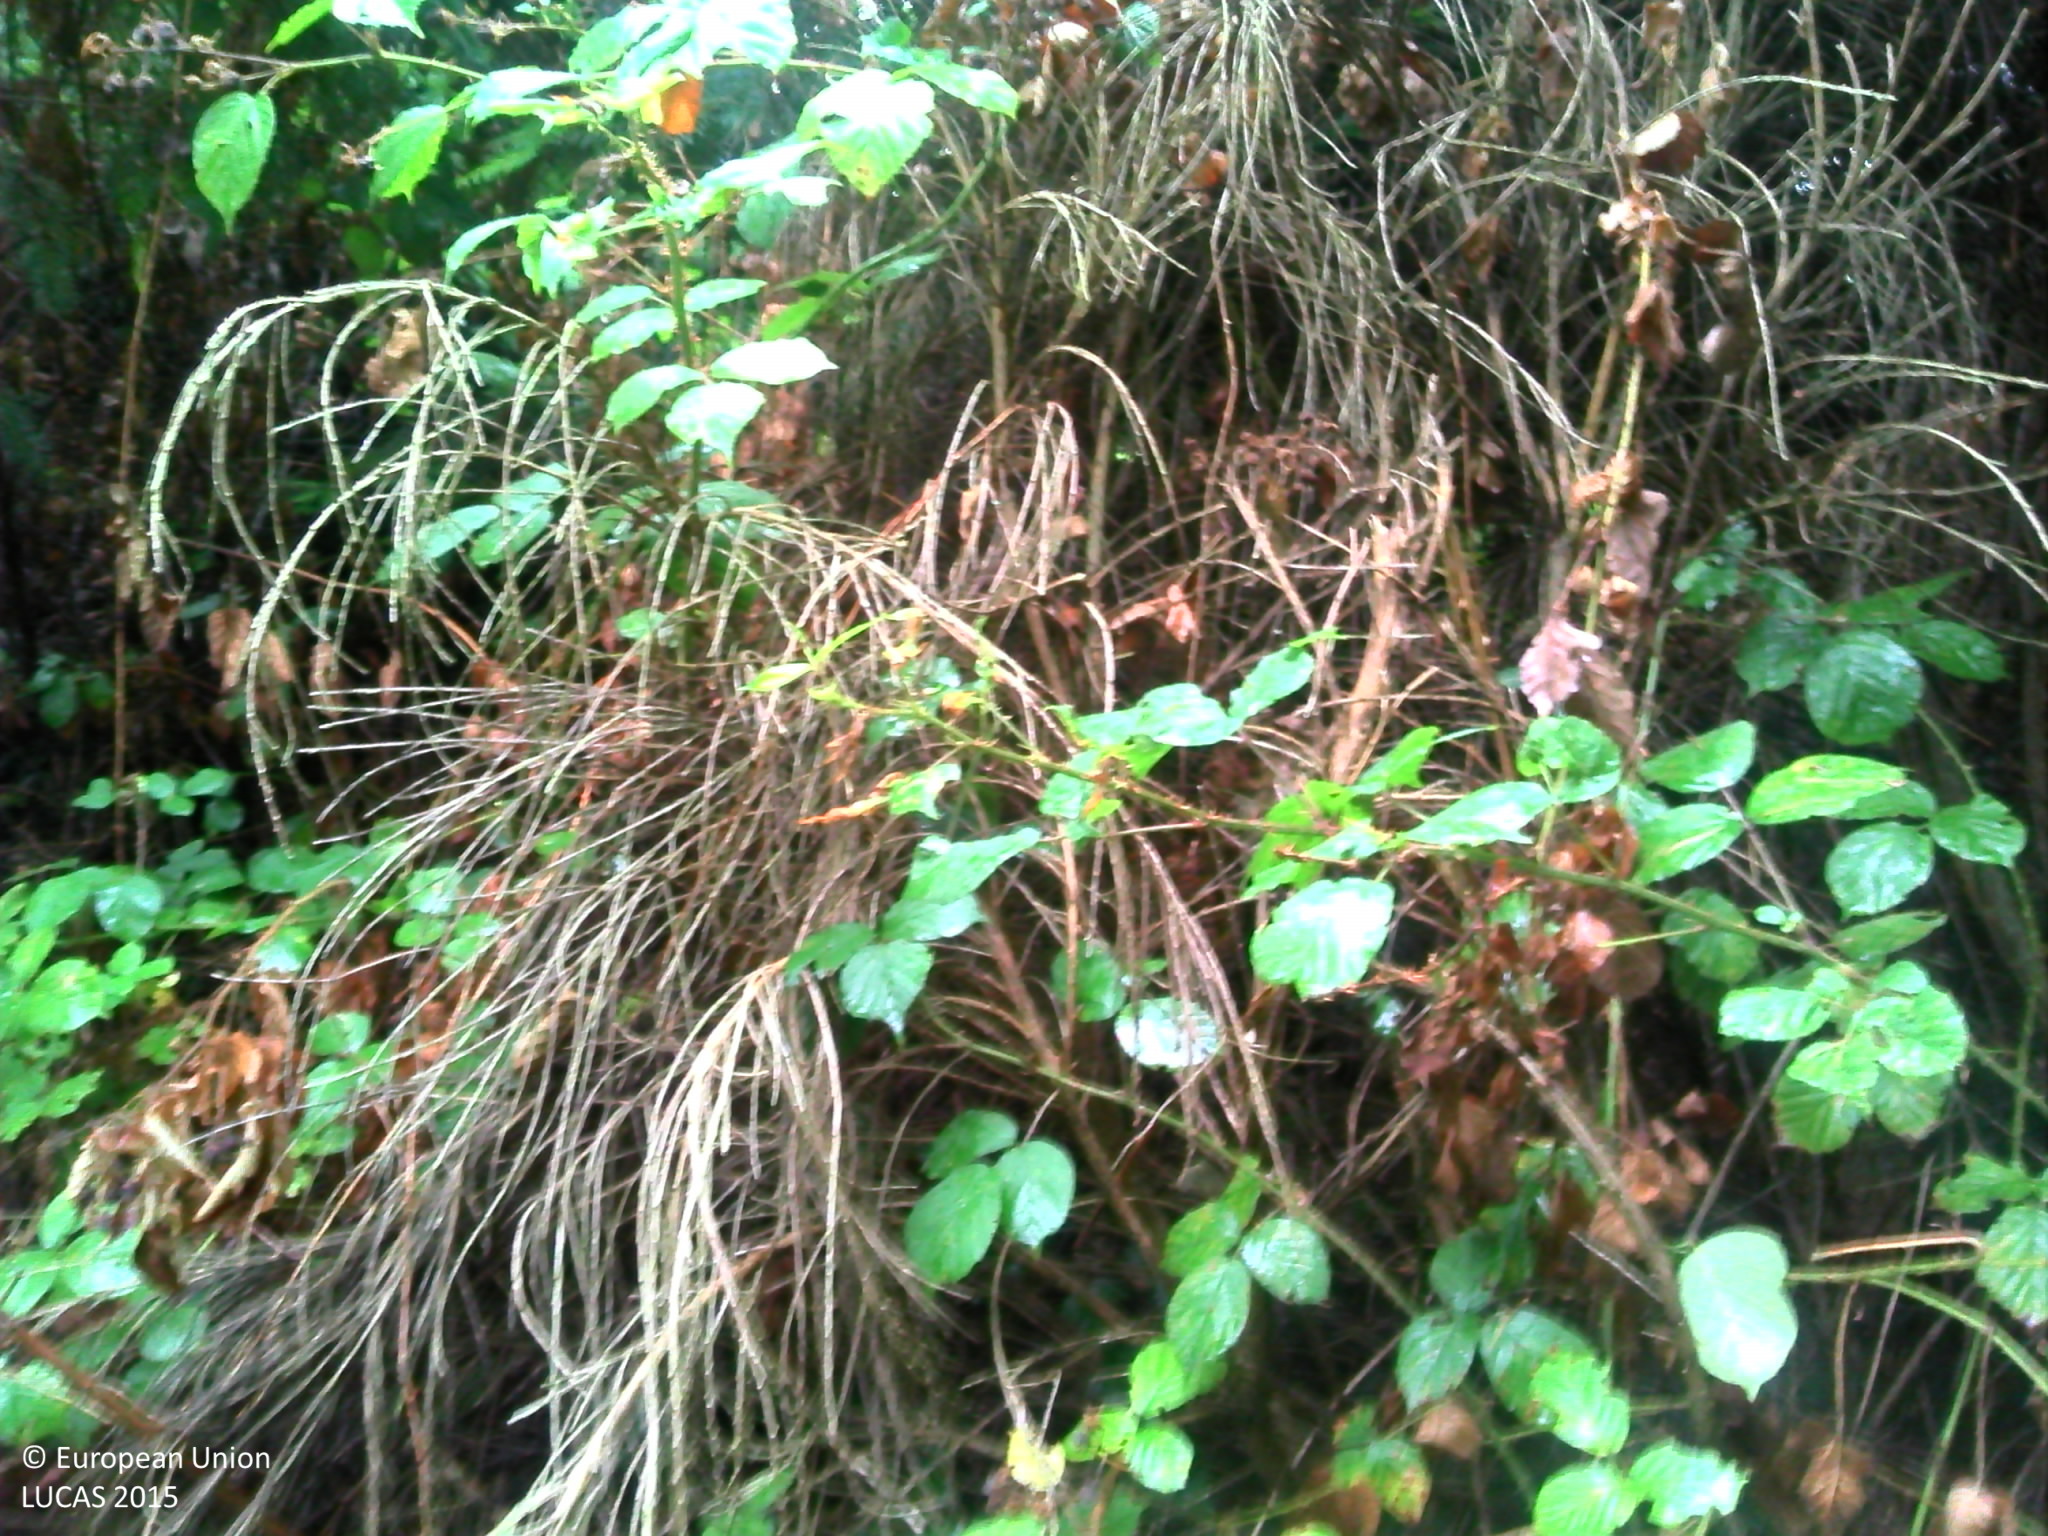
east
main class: Woodland
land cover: Spruce dominated coniferous woodland
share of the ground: > 75 %
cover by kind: coniferous forest trees 95 %, broadleaved forest trees 5 %
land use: Forestry
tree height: > 5 m
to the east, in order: Tracks; Spruce dominated coniferous woodland; Tracks; Spruce dominated coniferous woodland; Tracks; Spruce dominated mixed woodland
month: August
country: FR
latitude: 46.0063
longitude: 0.9873
